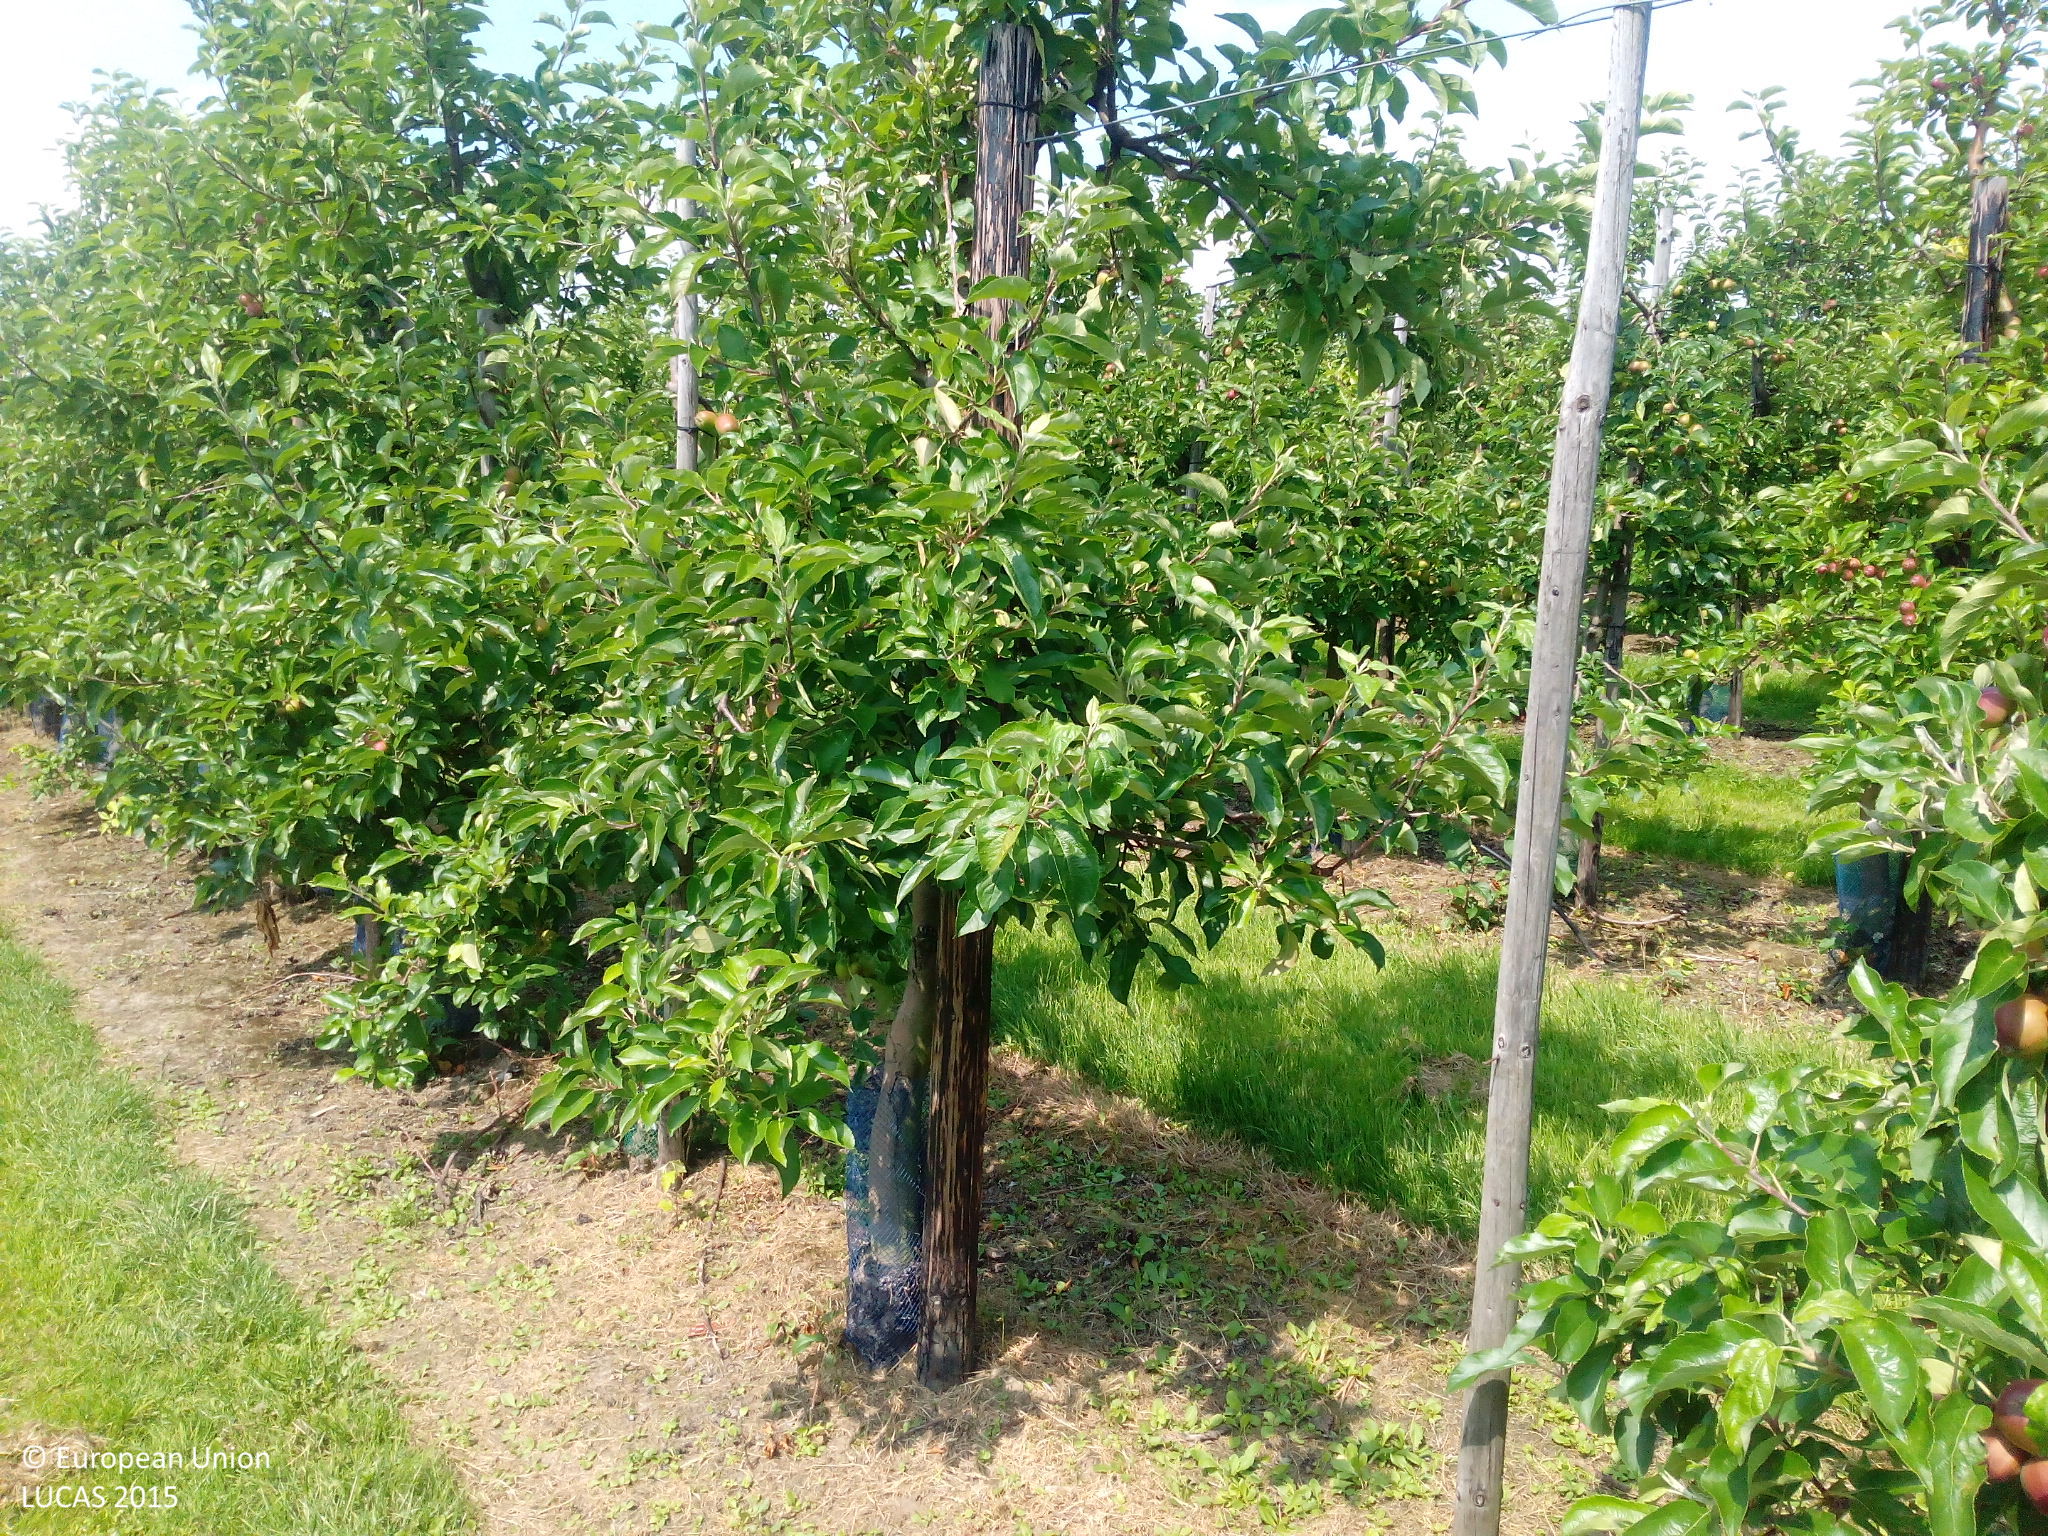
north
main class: Cropland
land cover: Pear fruit
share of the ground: 50 - 75 %
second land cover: Grassland without tree/shrub cover
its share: 25 - 50 %
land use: Agriculture (excluding fallow land and kitchen gardens)
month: June
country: NL
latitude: 51.6642
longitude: 4.6904
